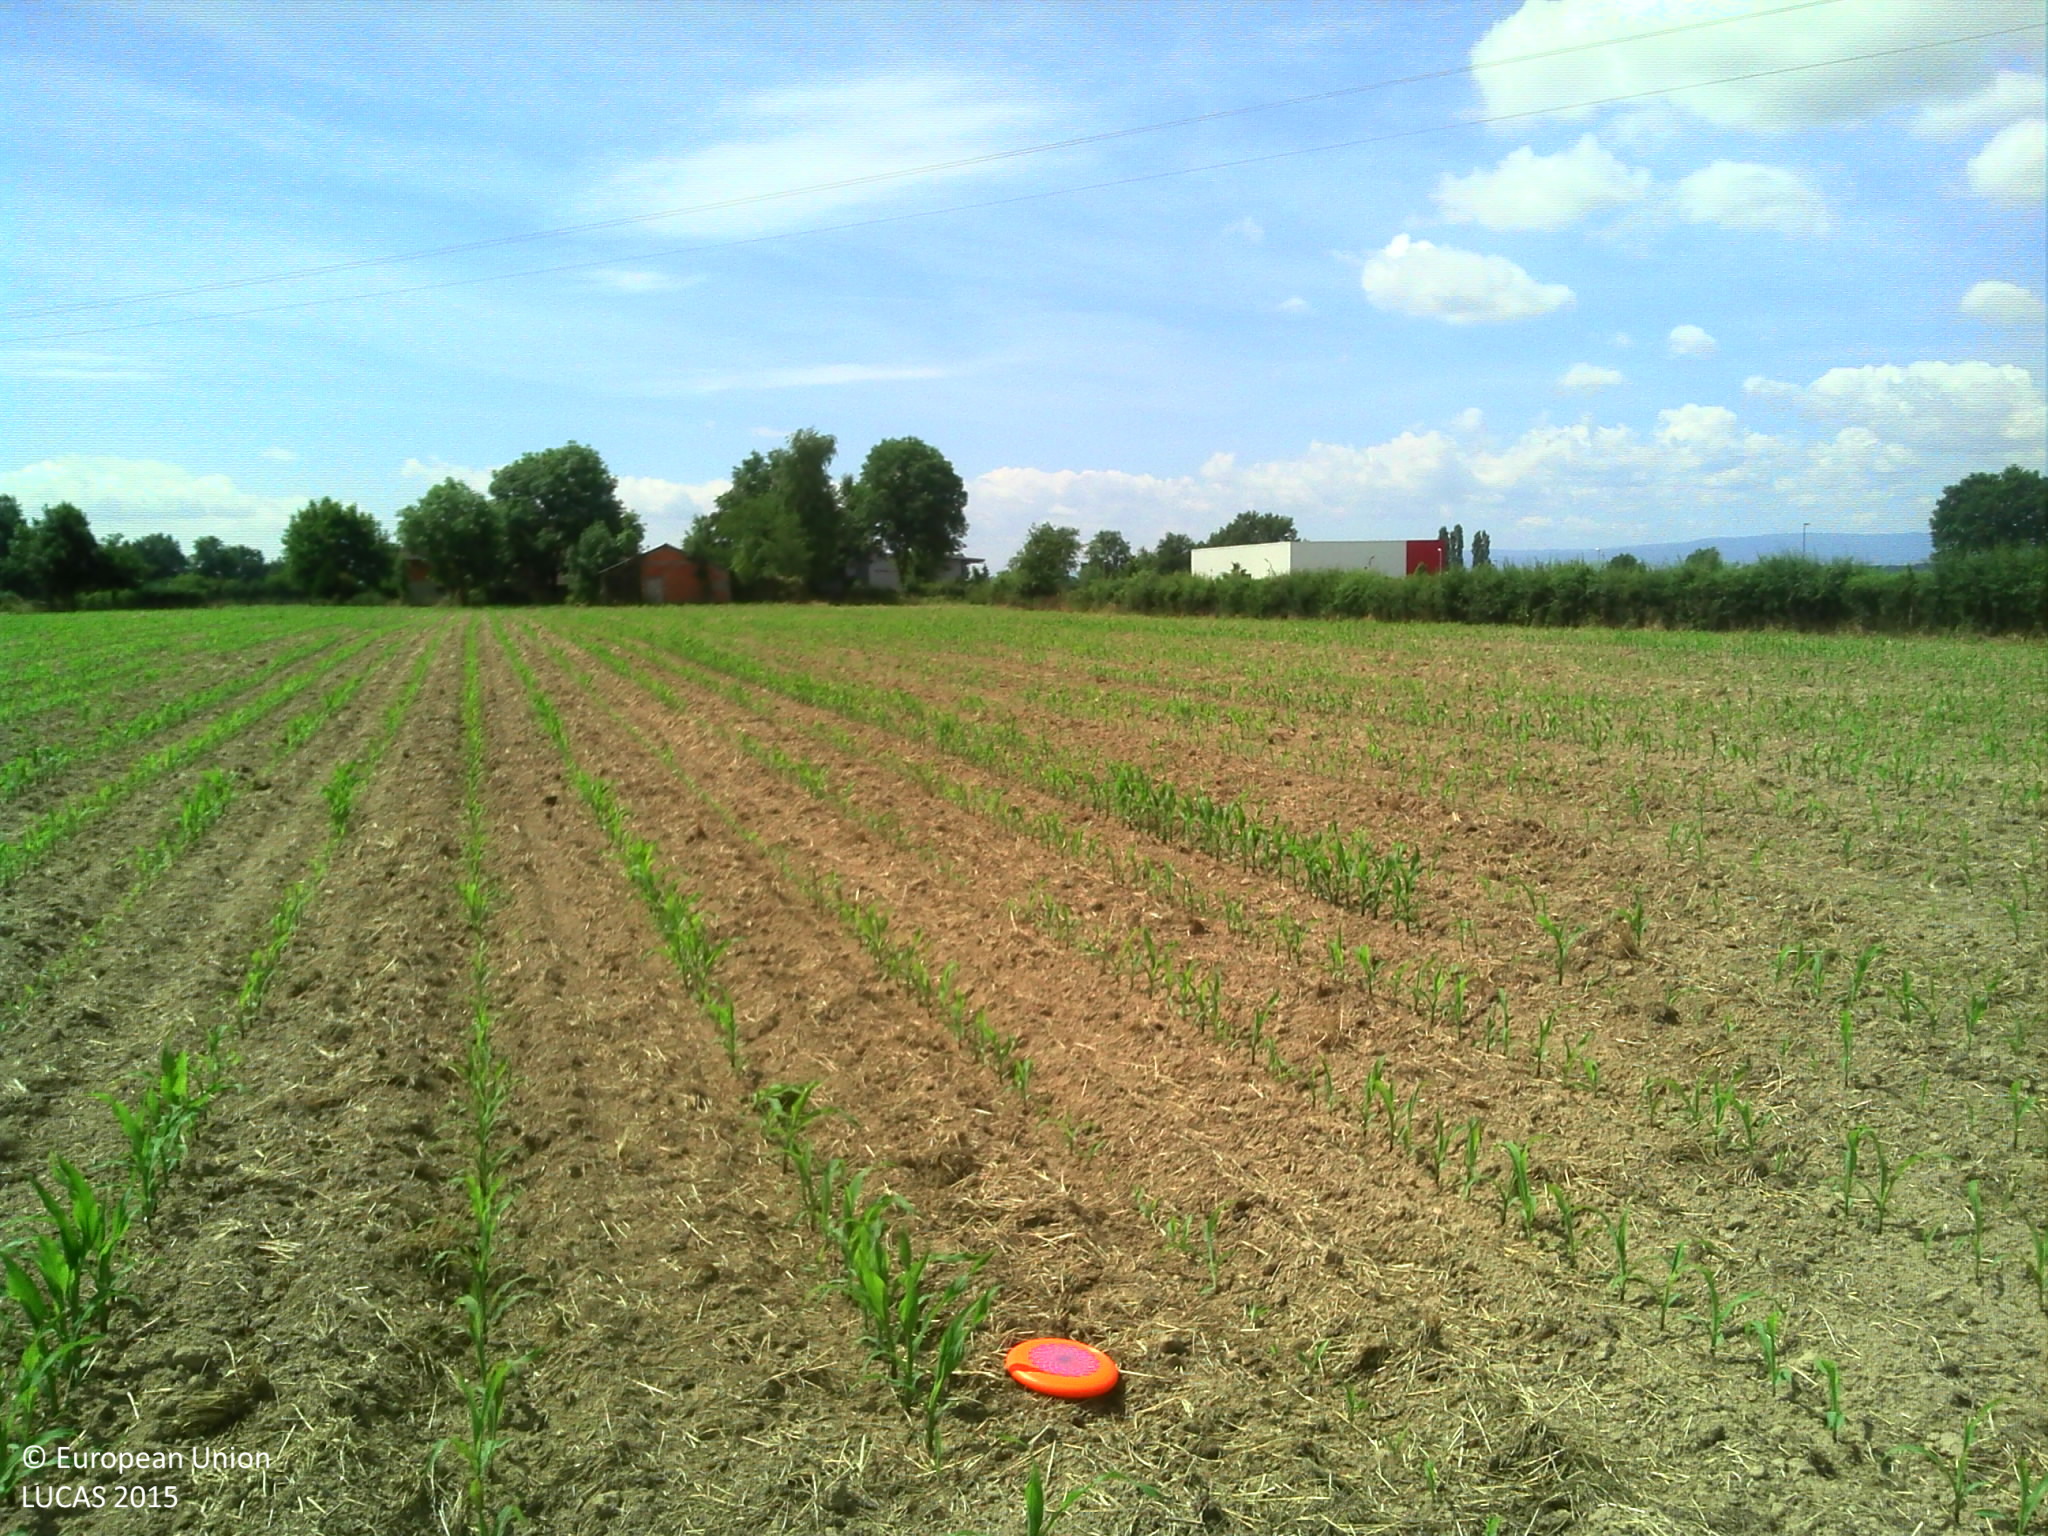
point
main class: Cropland
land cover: Maize
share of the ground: 10 - 25 %
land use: Agriculture (excluding fallow land and kitchen gardens)
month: June
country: FR
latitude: 46.2935
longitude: 4.0425
